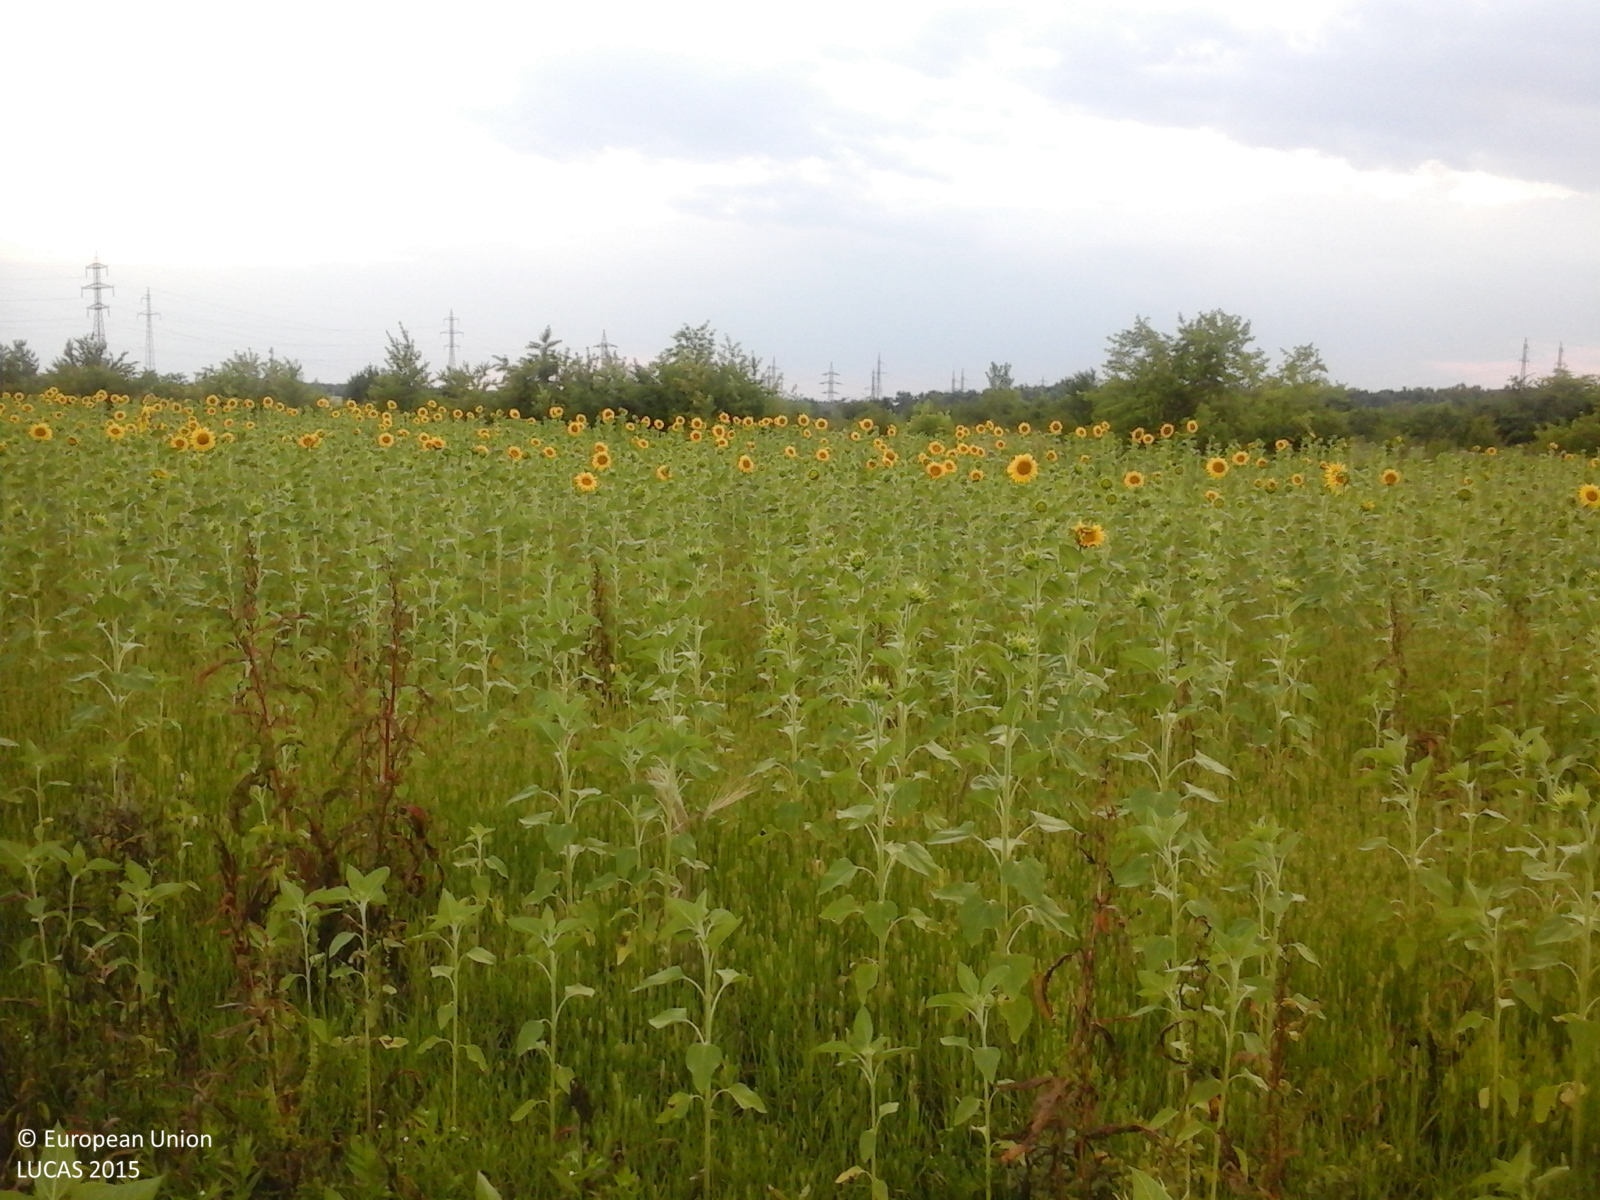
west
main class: Cropland
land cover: Sunflower
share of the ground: 50 - 75 %
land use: Agriculture (excluding fallow land and kitchen gardens)
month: July
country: RO
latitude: 43.9597
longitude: 25.2987
